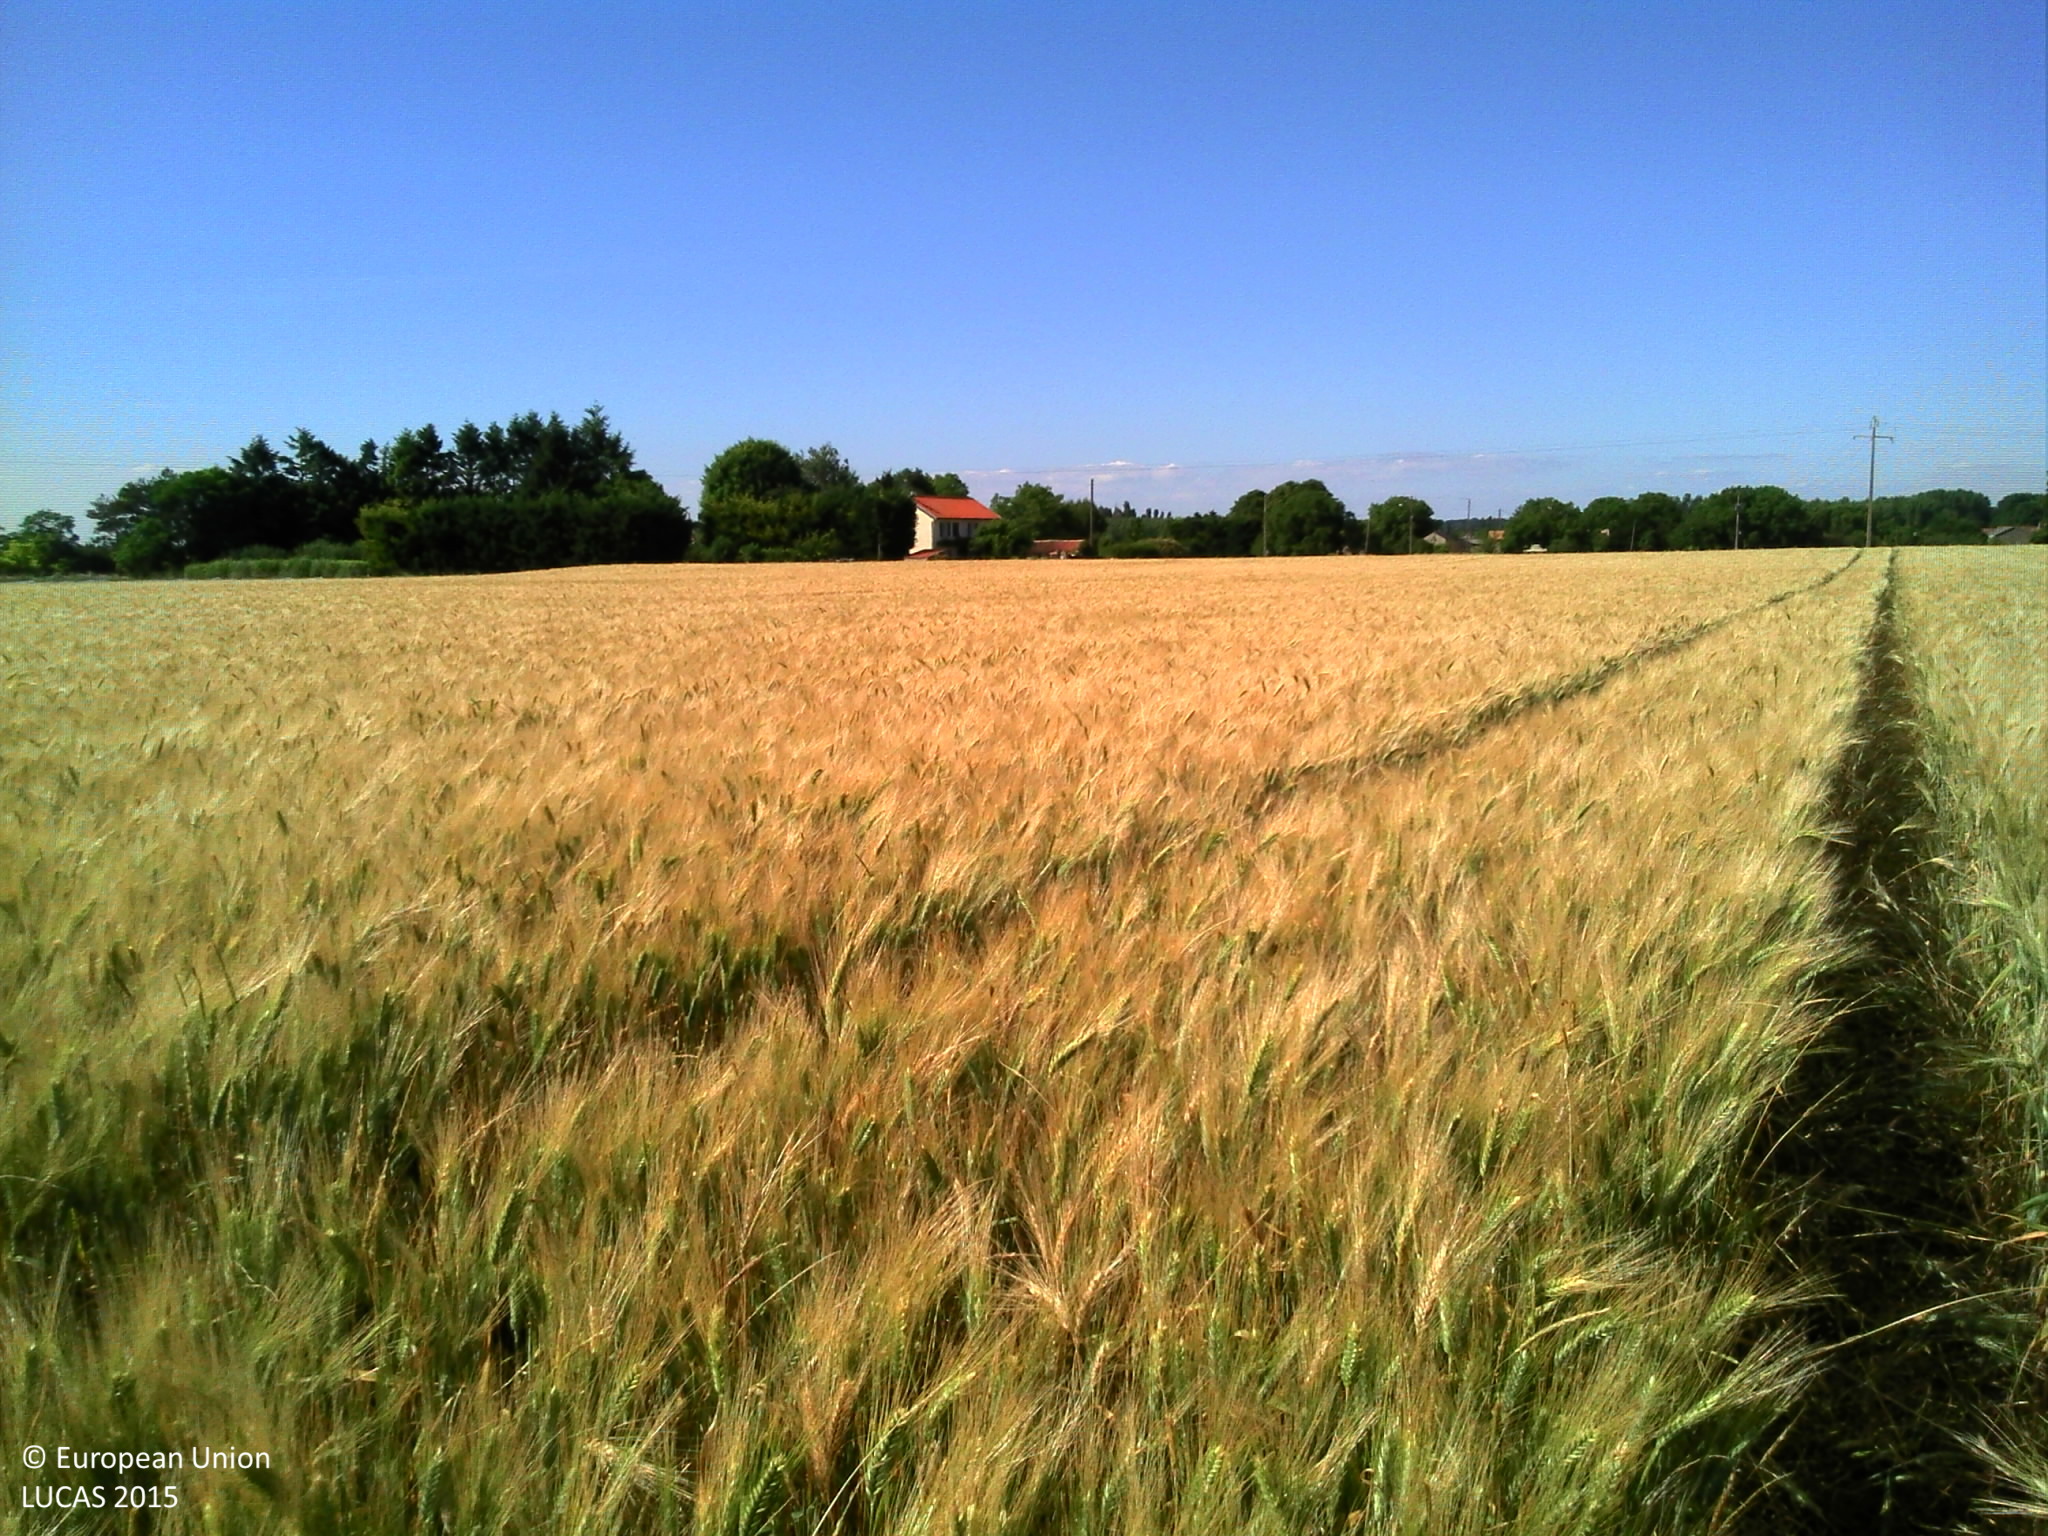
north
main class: Cropland
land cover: Barley
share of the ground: > 75 %
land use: Agriculture (excluding fallow land and kitchen gardens)
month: June
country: FR
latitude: 46.8191
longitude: 0.1347
